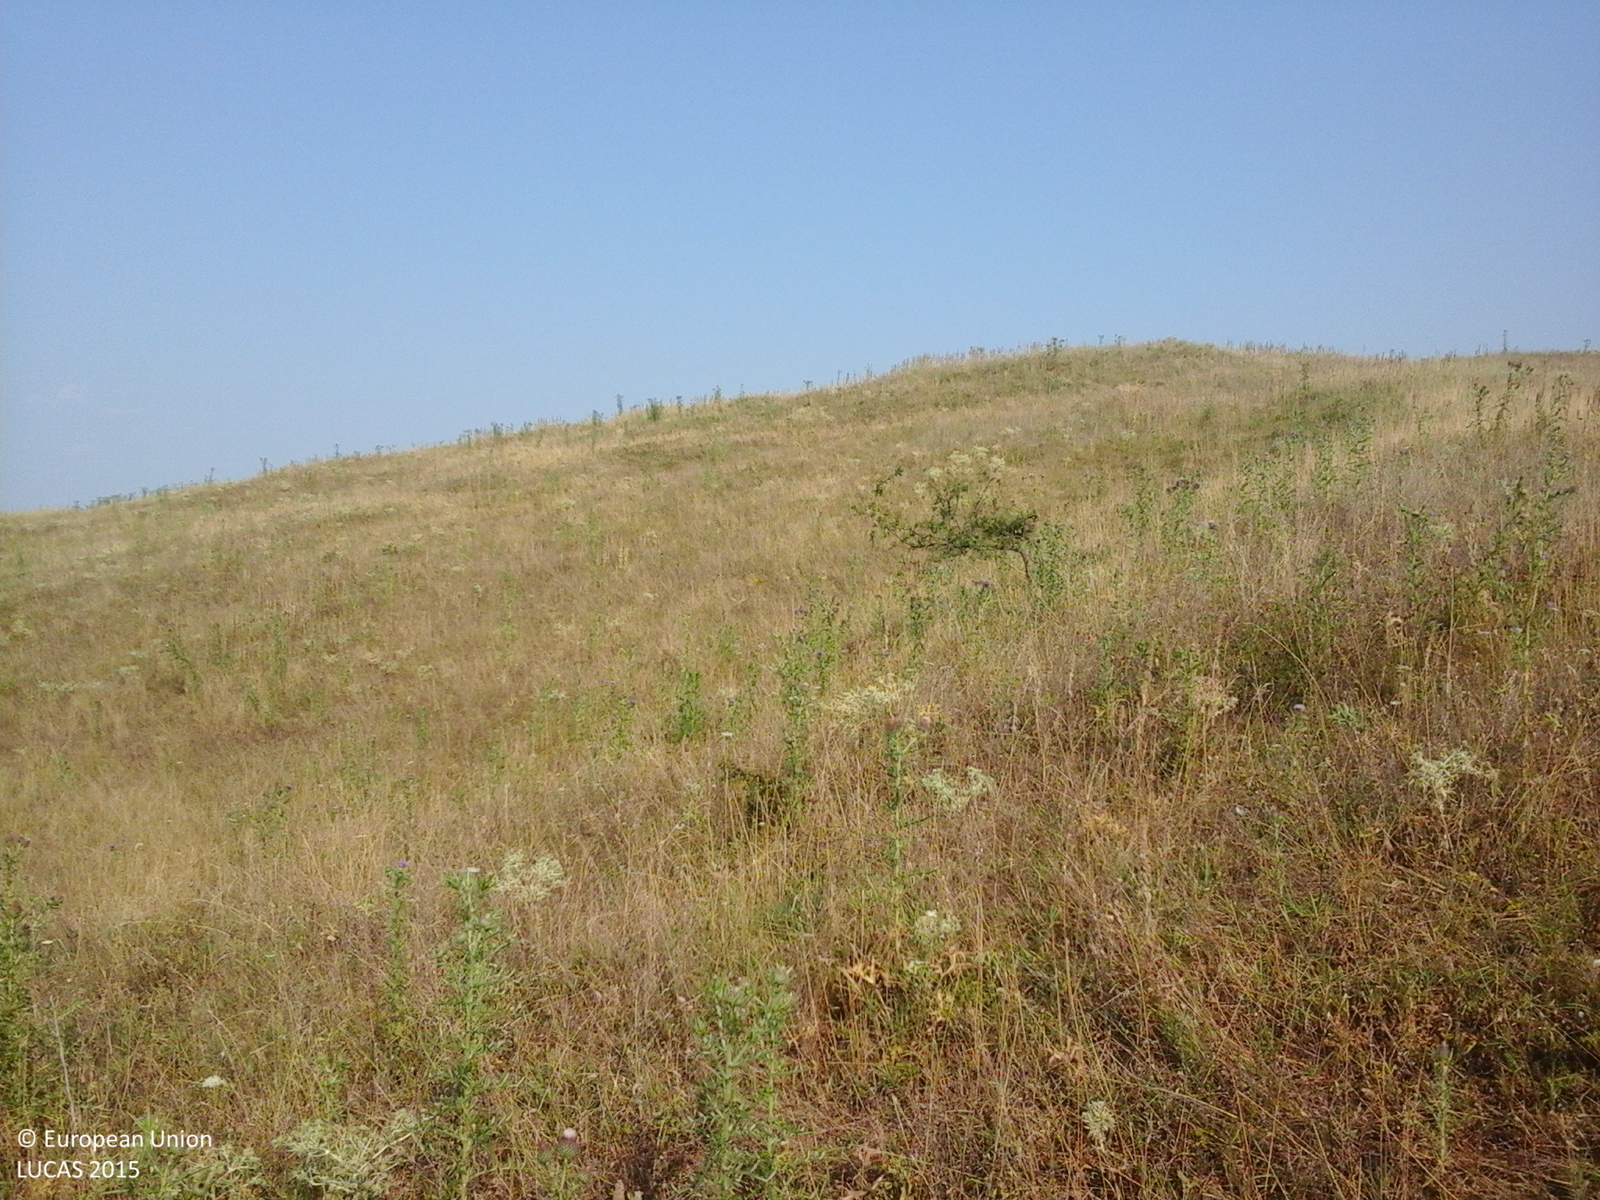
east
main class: Grassland
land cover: Grassland without tree/shrub cover
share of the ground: > 75 %
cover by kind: herbaceous plants 100 %
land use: Agriculture (excluding fallow land and kitchen gardens)
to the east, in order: Grassland without tree/shrub cover
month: August
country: RO
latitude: 44.4067
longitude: 23.5521
